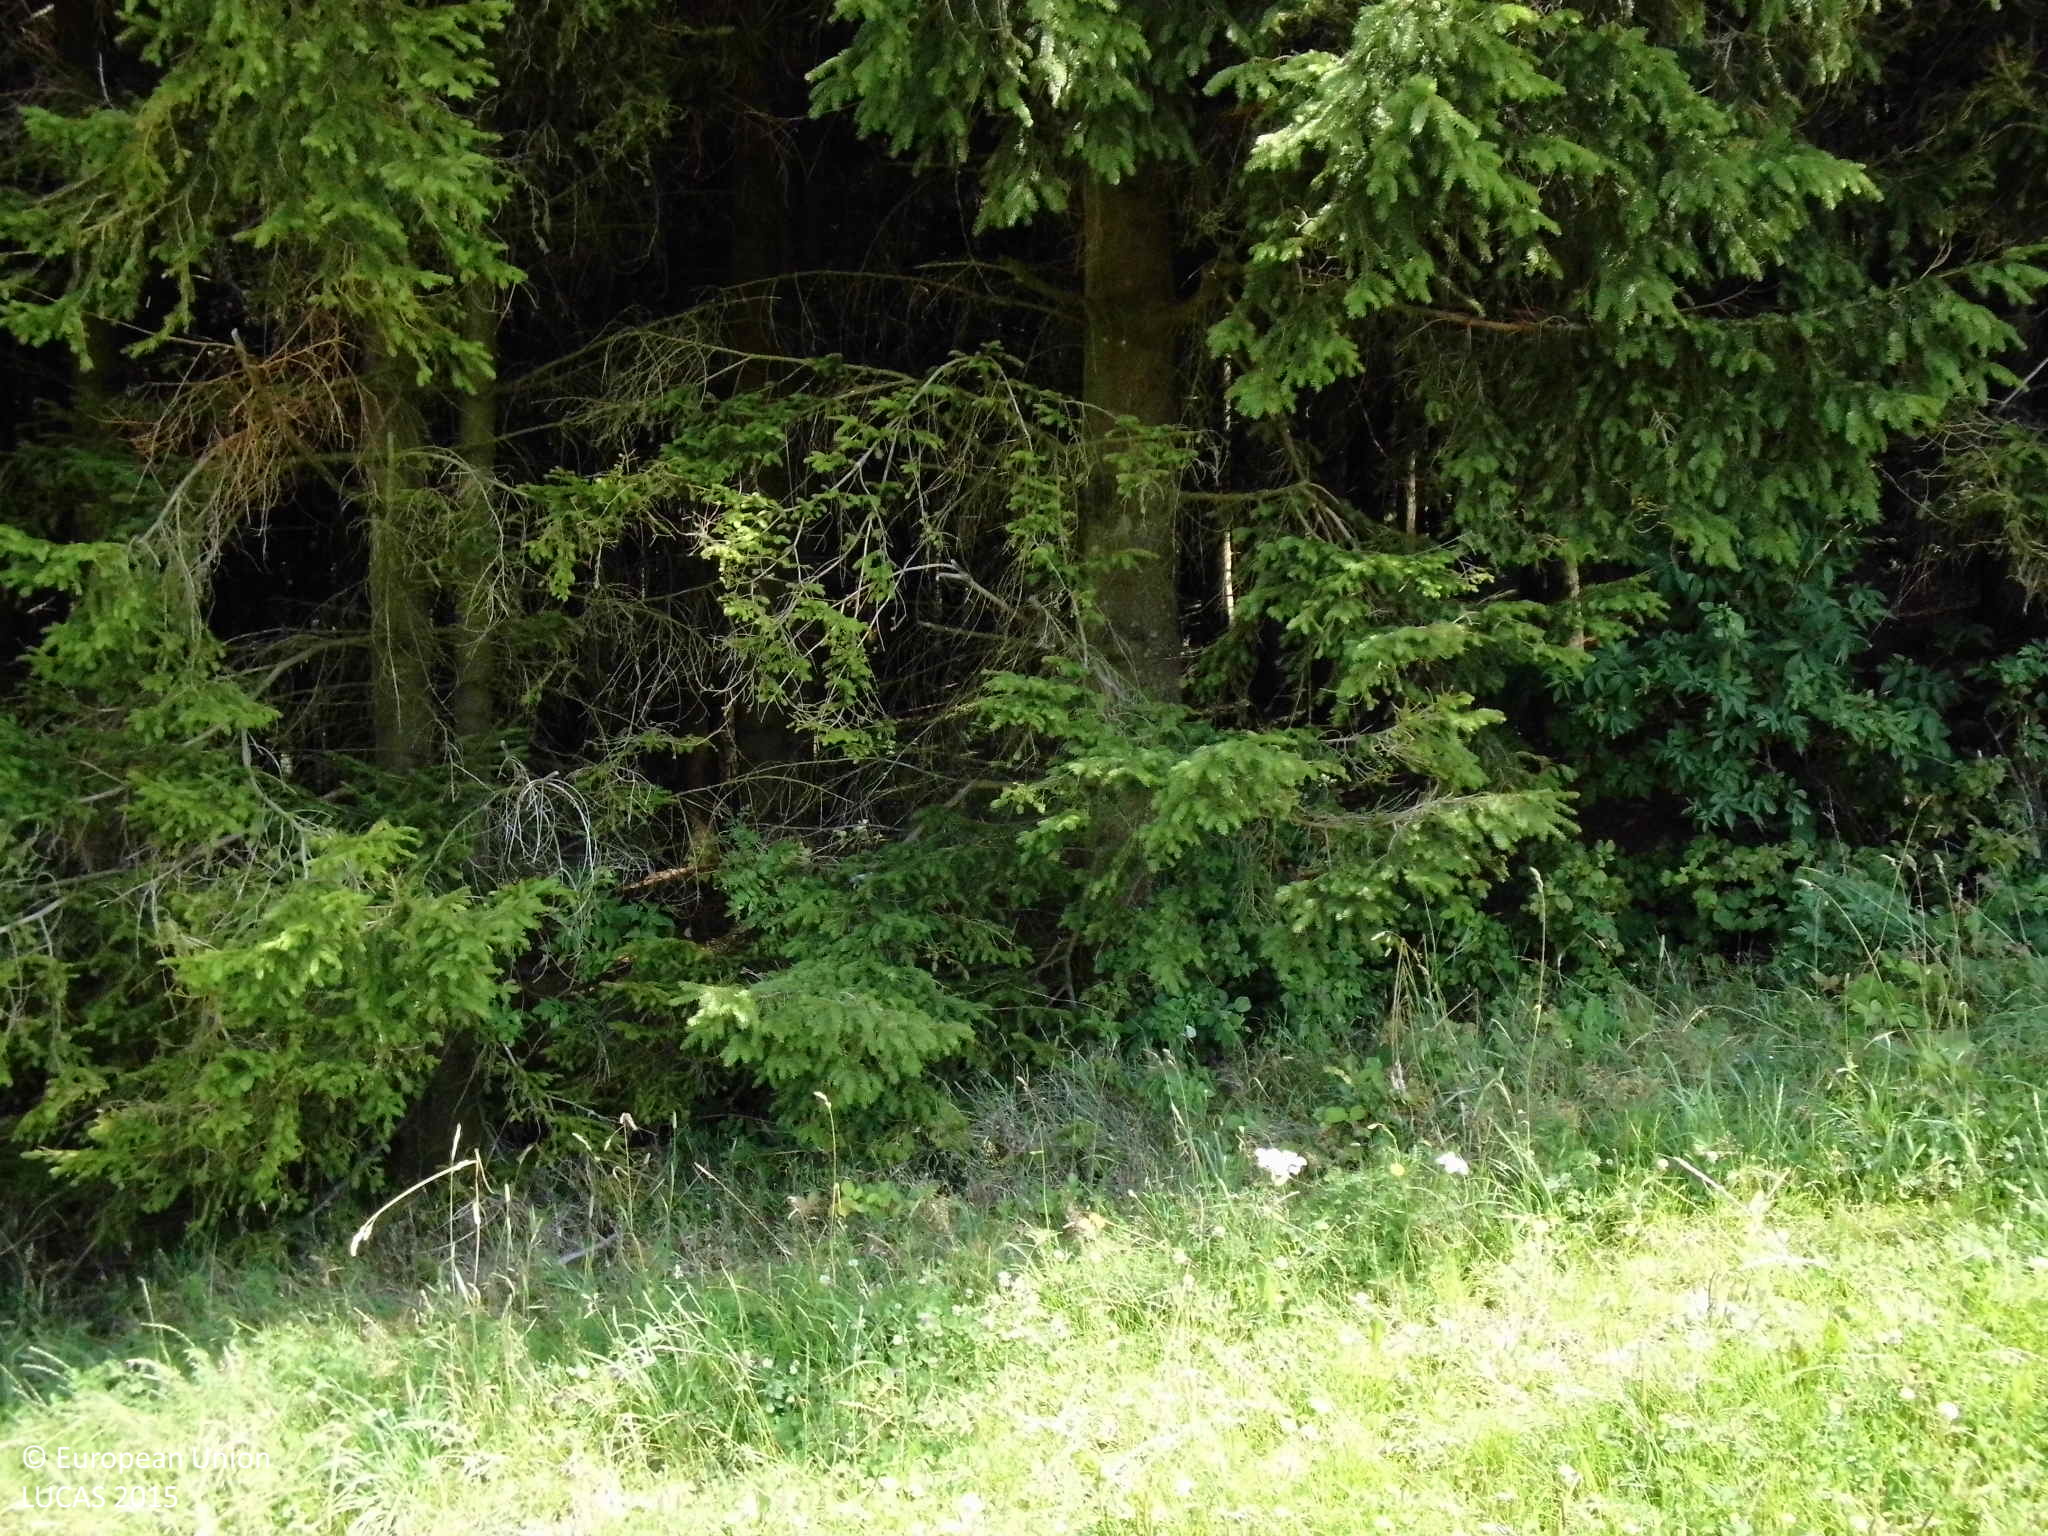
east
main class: Cropland
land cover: Barley
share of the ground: > 75 %
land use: Agriculture (excluding fallow land and kitchen gardens)
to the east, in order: Barley; Fences; Grass margins; Tracks; Spruce dominated coniferous woodland; Shruby margins; Spruce dominated coniferous woodland; Shruby margins; Spruce dominated coniferous woodland; Tracks; Spruce dominated coniferous woodland
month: August
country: DE
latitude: 51.0732
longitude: 8.4732
